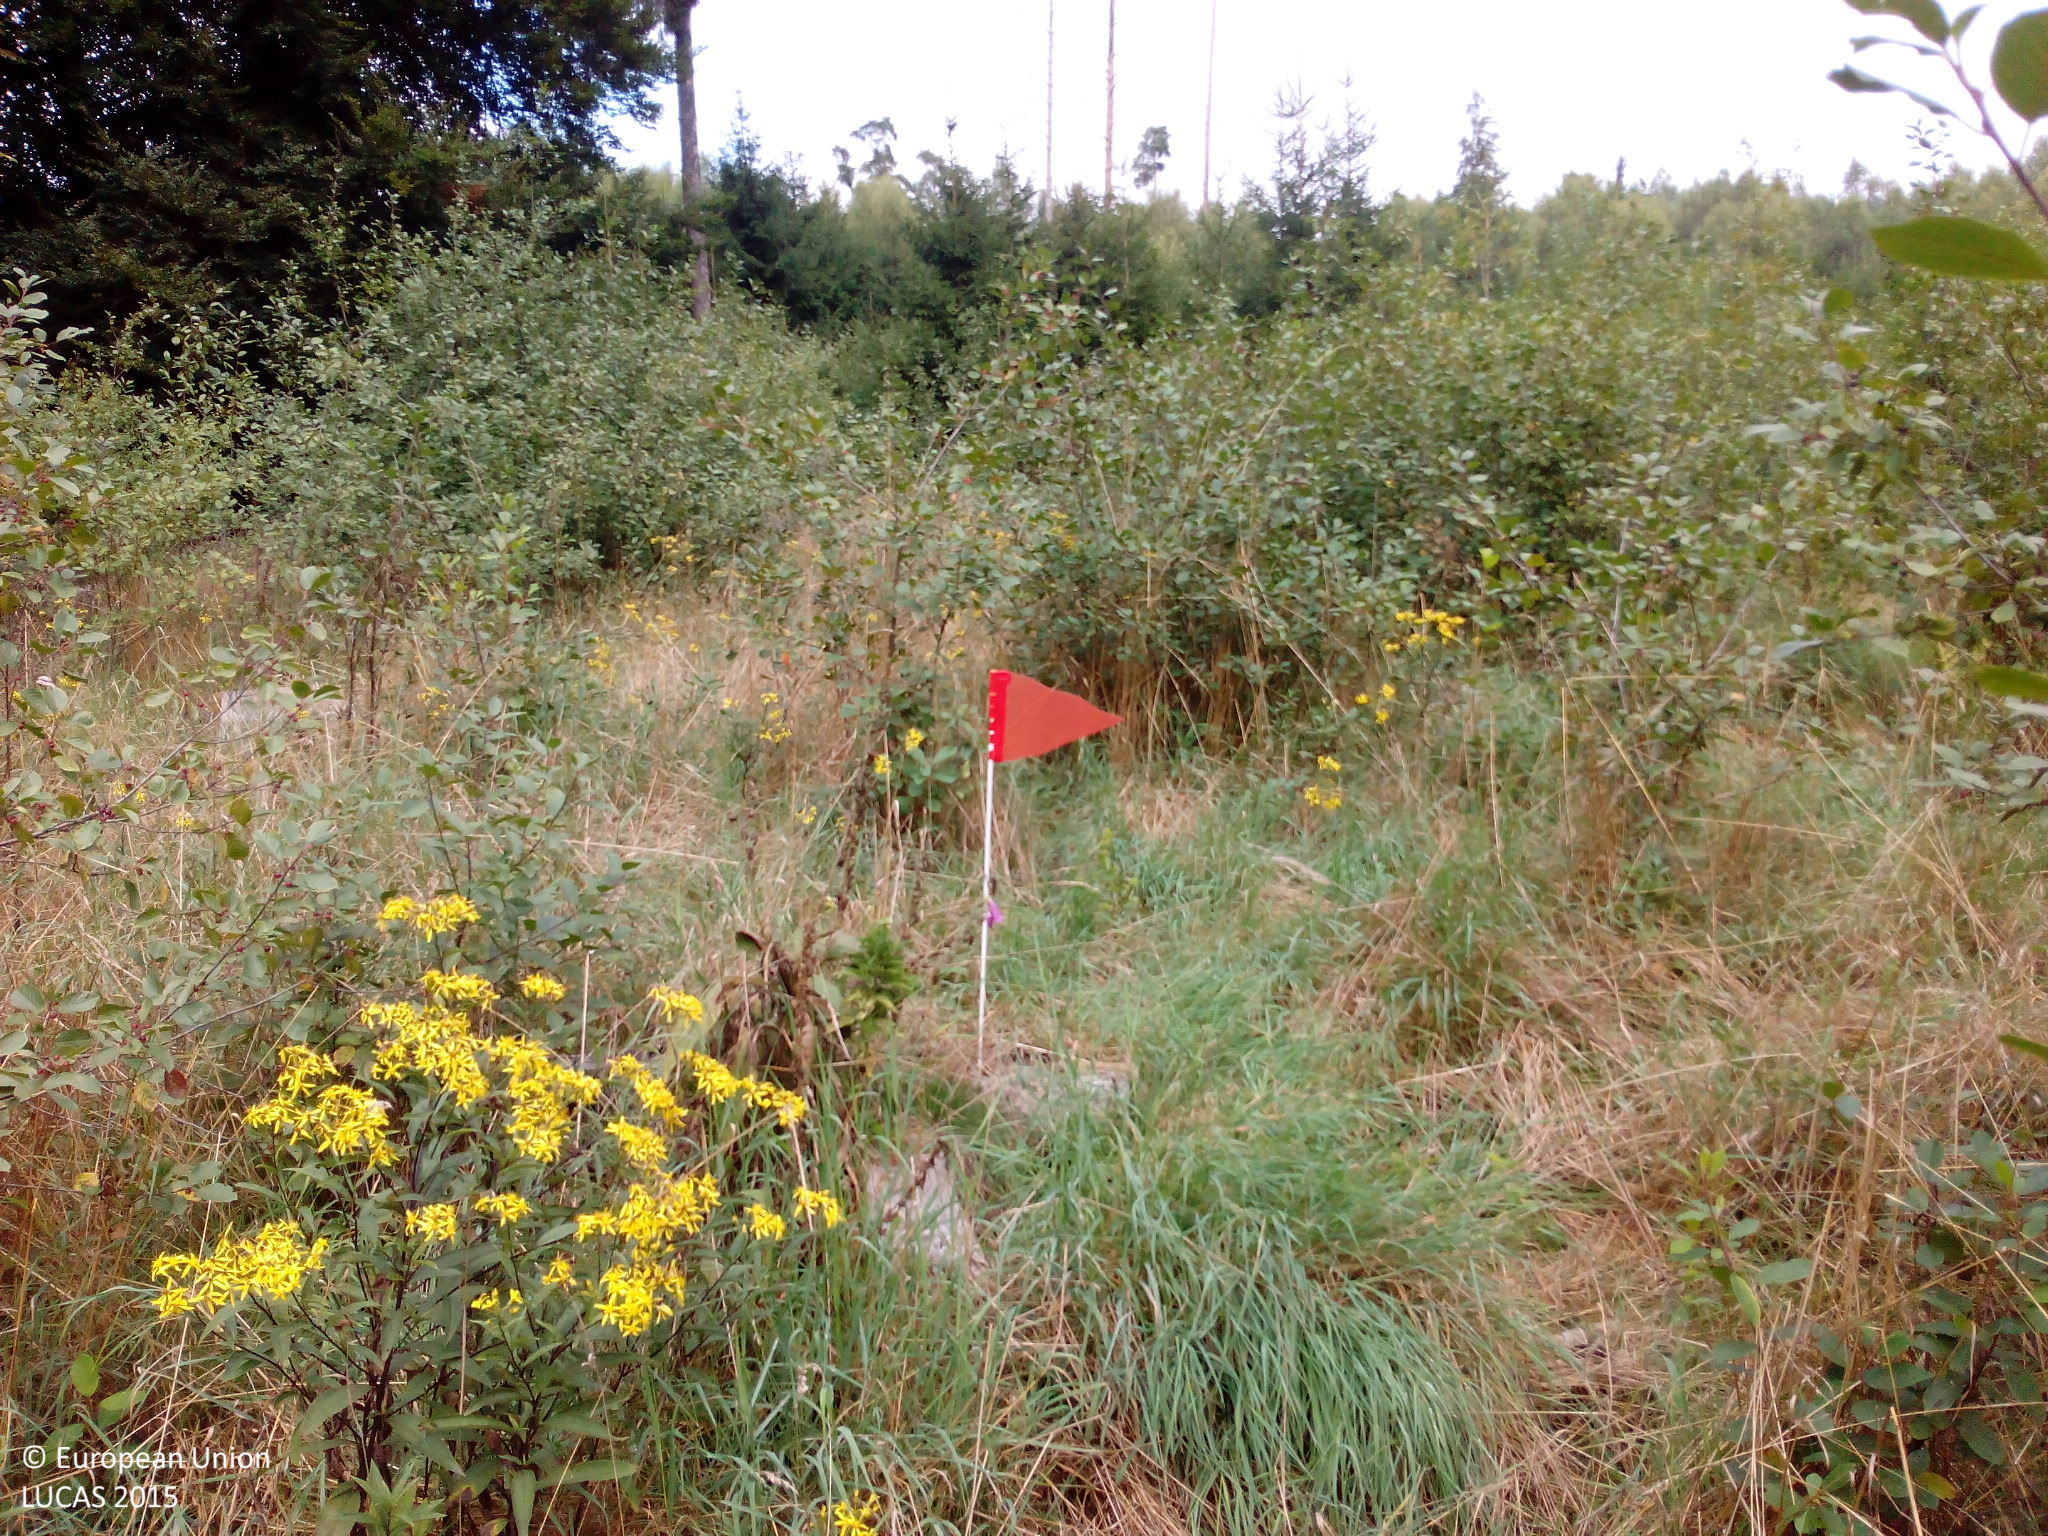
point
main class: Shrubland
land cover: Shrubland with sparse tree cover
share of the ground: > 75 %
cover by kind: shrubs 70 %, herbaceous plants 25 %, broadleaved forest trees 5 %
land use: Forestry
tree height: < 5 m
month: August
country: DE
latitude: 50.0861
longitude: 7.5545
